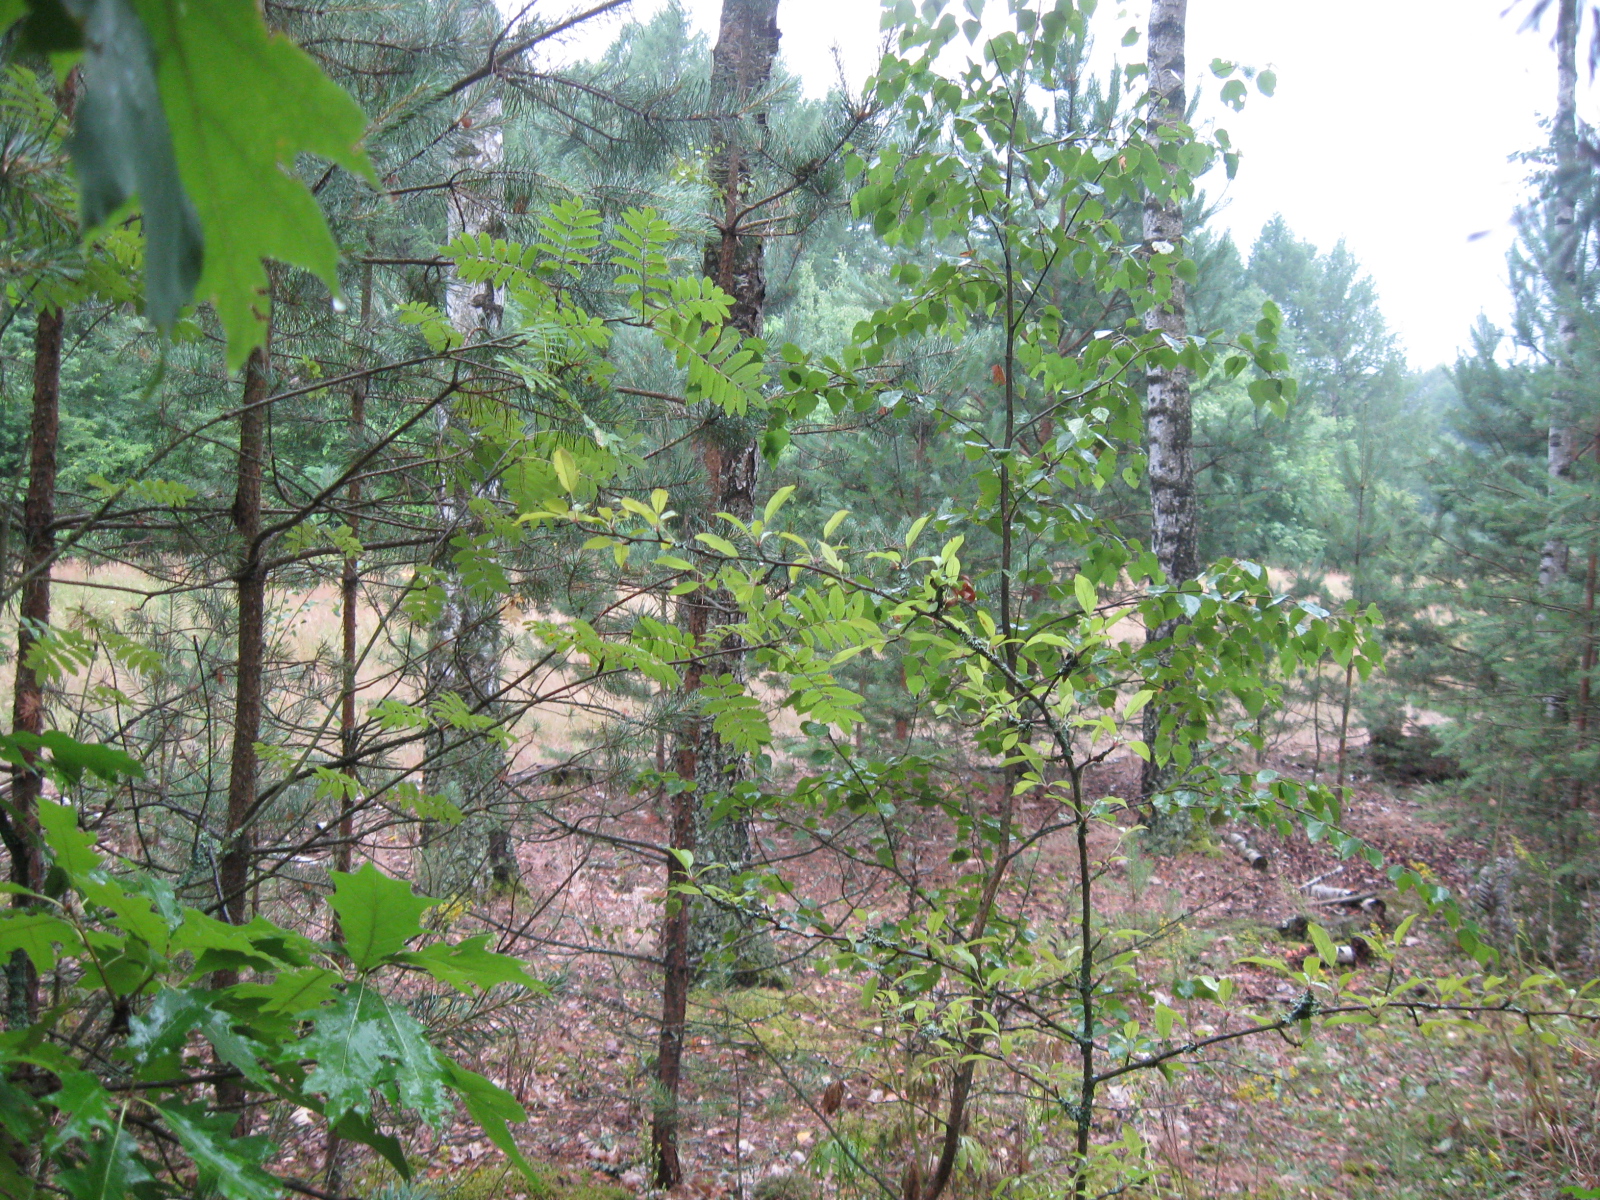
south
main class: Woodland
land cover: Pine dominated mixed woodland
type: hemiboreal forest and nemoral coniferous forest and mixed broadleaved-coniferous forest
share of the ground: > 75 %
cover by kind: coniferous forest trees 50 %, broadleaved forest trees 30 %, herbaceous plants 10 %, shrubs 5 %, lichens and mosses 5 %
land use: Forestry
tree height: > 5 m
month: July
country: LT
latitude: 53.9934
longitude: 23.6459
